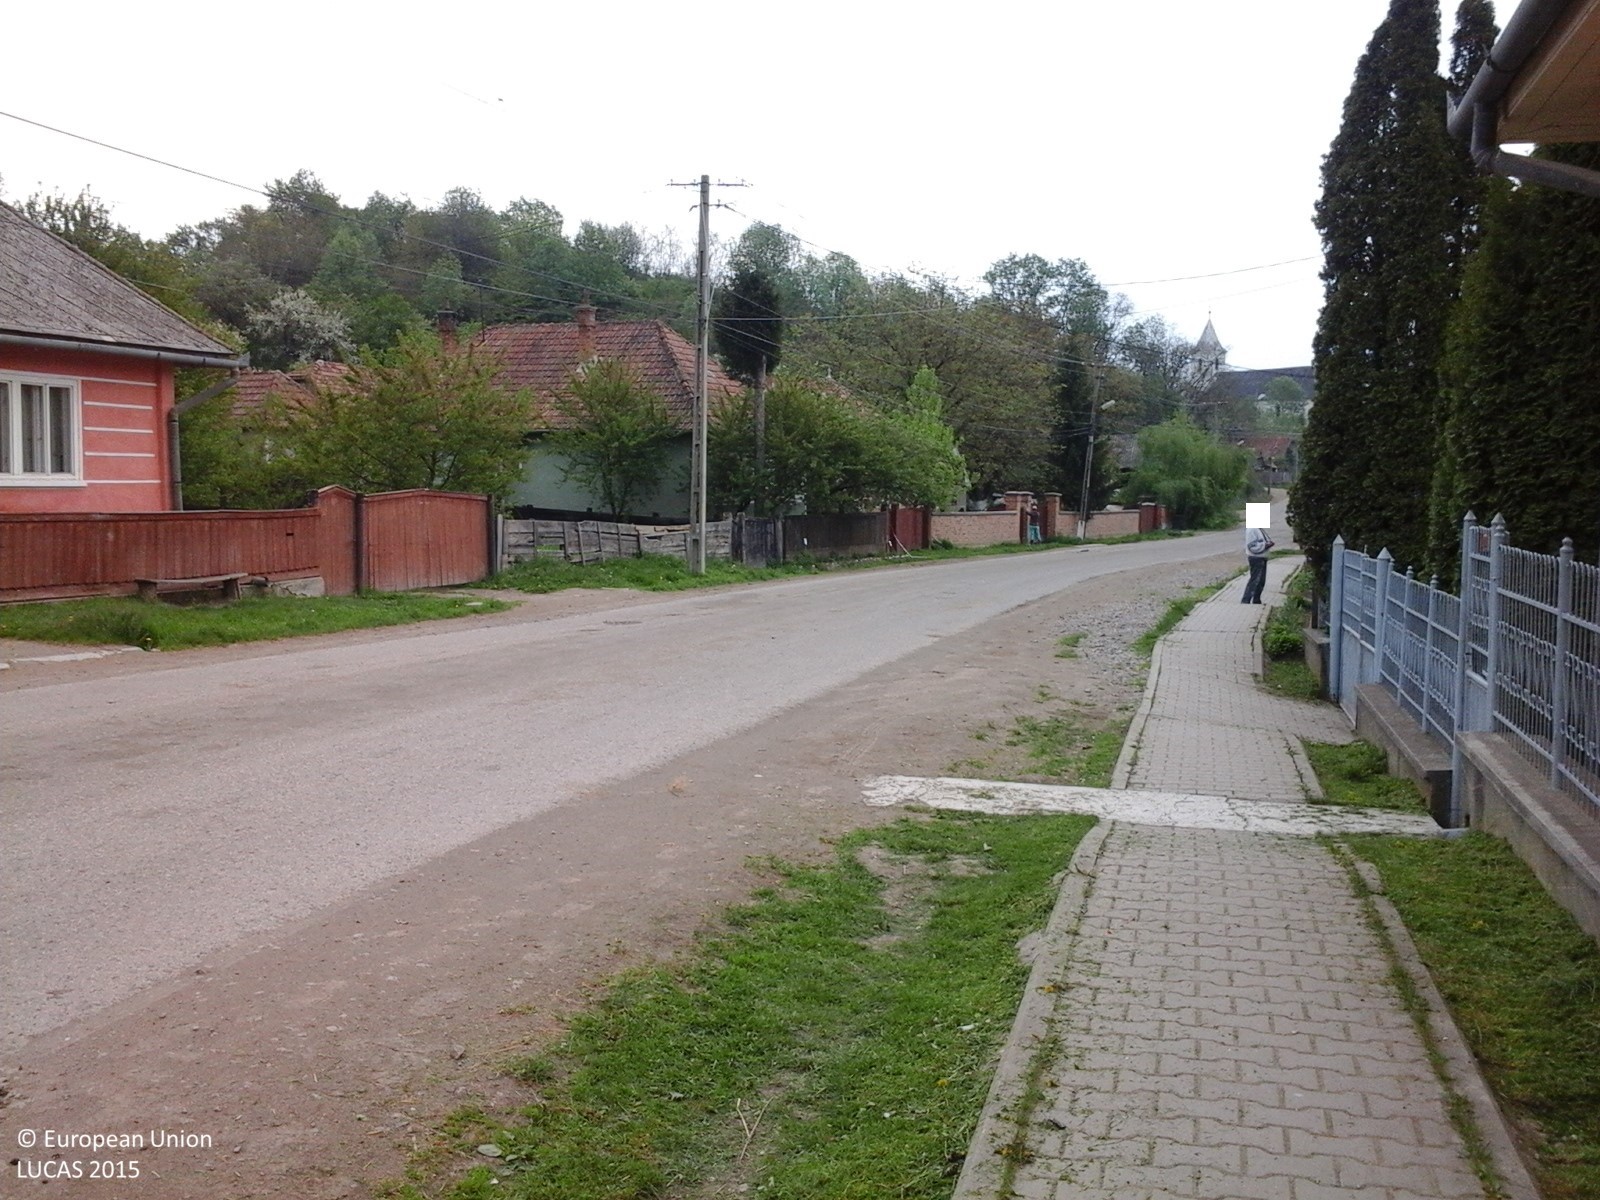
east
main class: Cropland
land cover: Apple fruit
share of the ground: 25 - 50 %
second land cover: Grassland without tree/shrub cover
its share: > 75 %
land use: Kitchen garden
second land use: Residential
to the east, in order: Apple fruit; Grassland without tree/shrub cover; Artificial constructions in urban areas; Broadleaved woodland
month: May
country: RO
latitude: 45.9799
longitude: 26.0065
